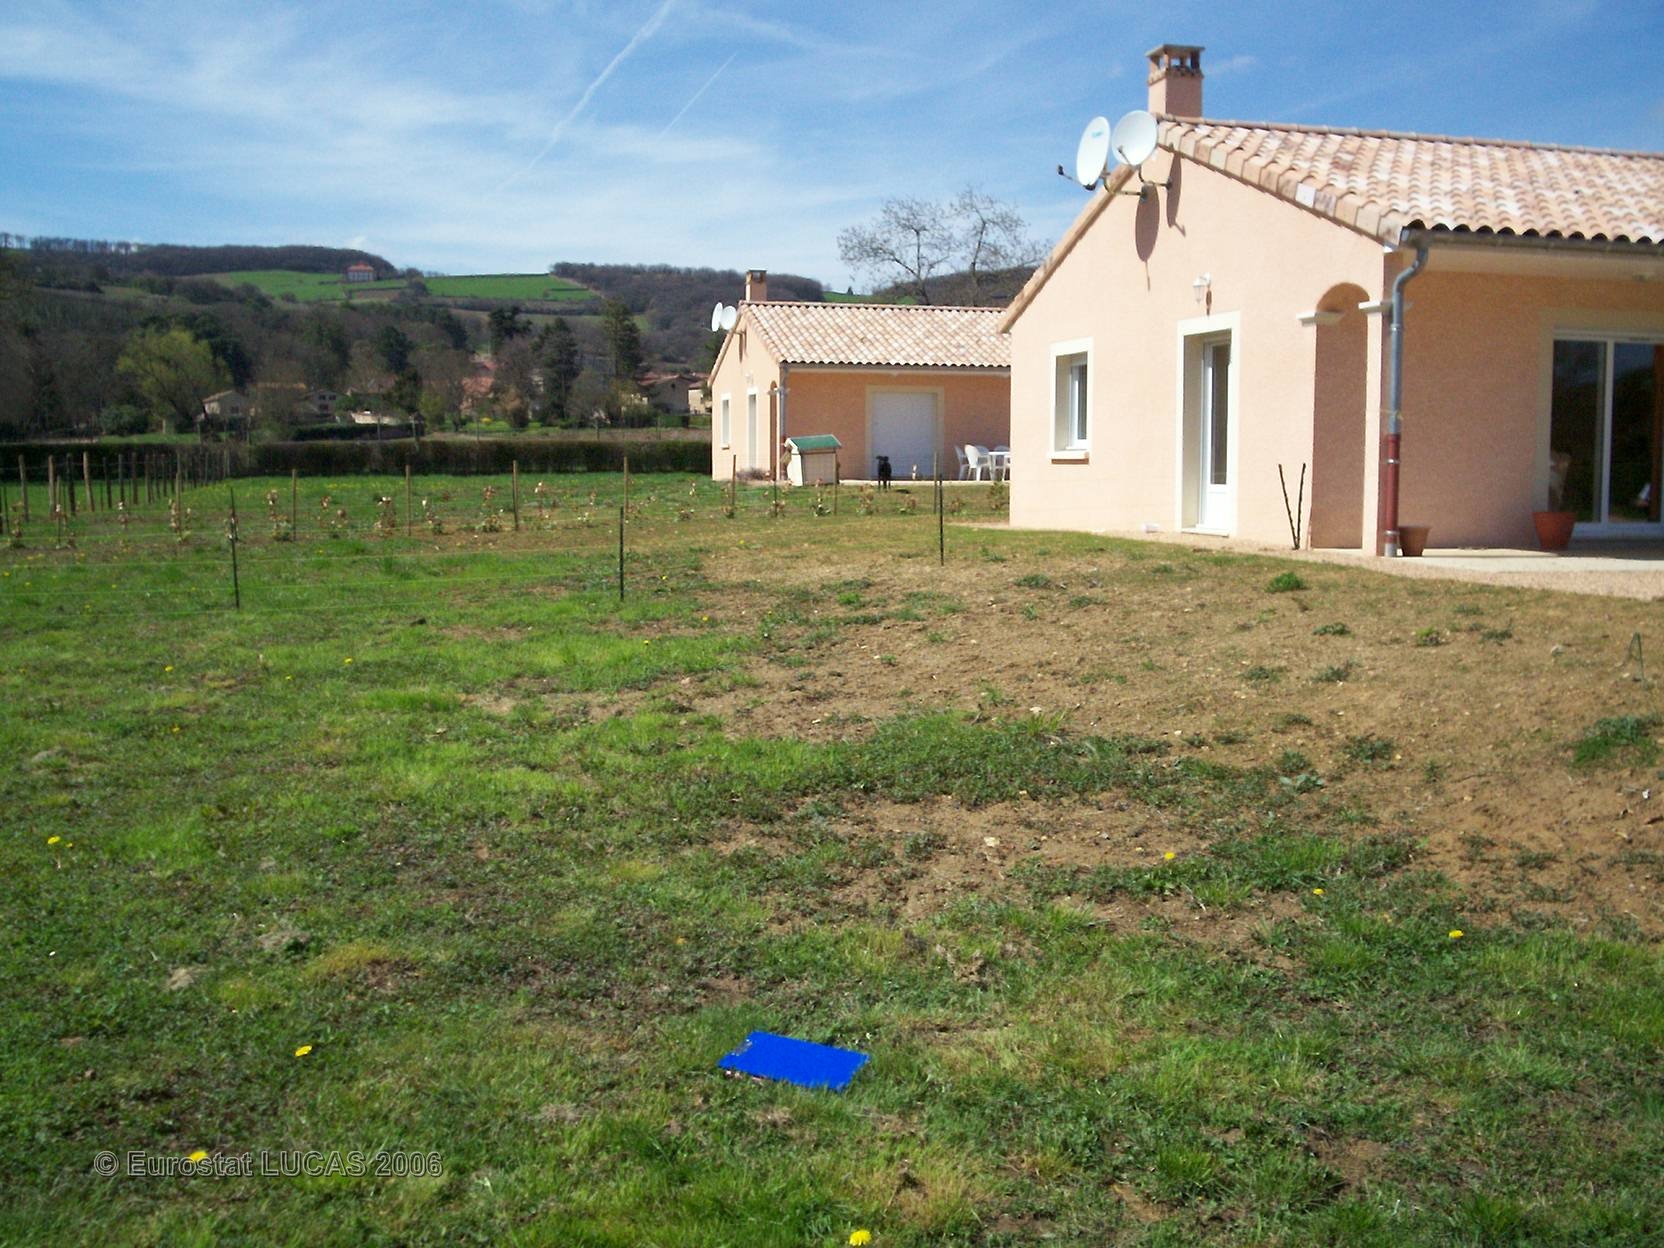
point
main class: Grassland
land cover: Grassland without tree/shrub cover
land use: Residential
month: April
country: FR
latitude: 46.4212
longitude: 4.7583
